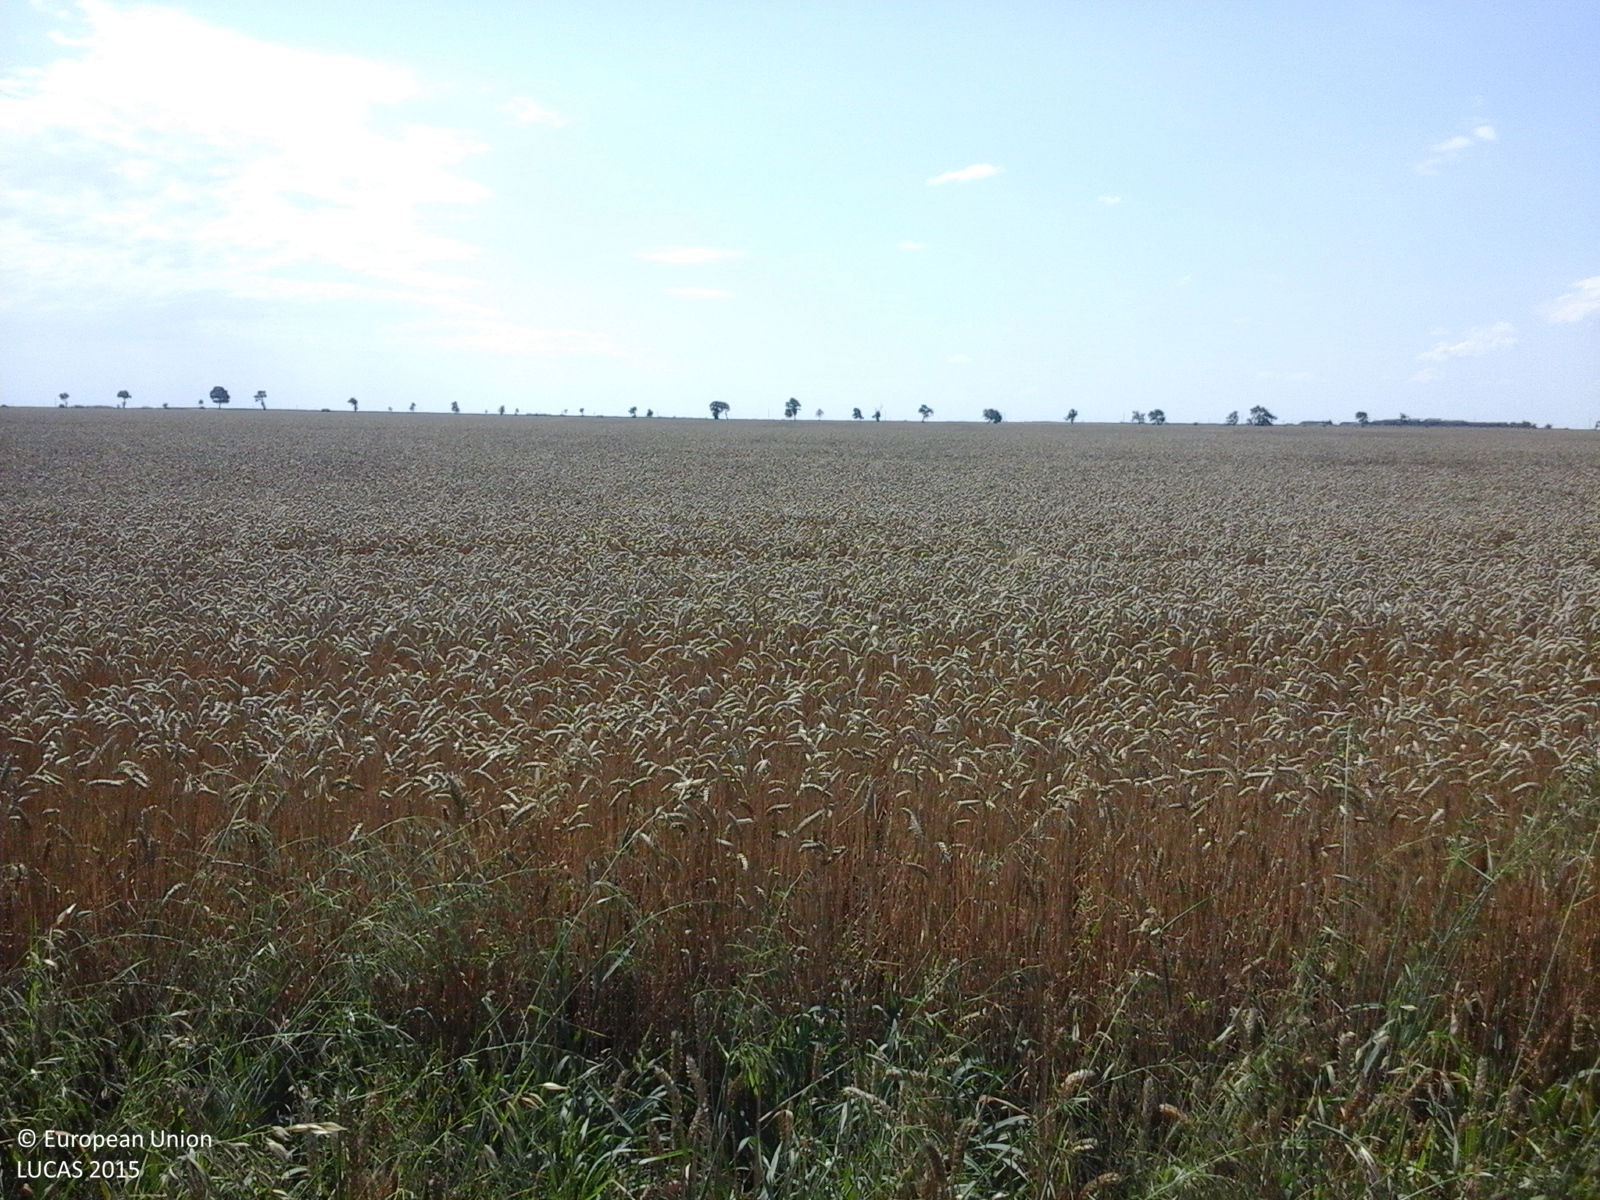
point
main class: Cropland
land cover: Common wheat
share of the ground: > 75 %
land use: Agriculture (excluding fallow land and kitchen gardens)
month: July
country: RO
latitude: 43.9494
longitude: 25.2450
